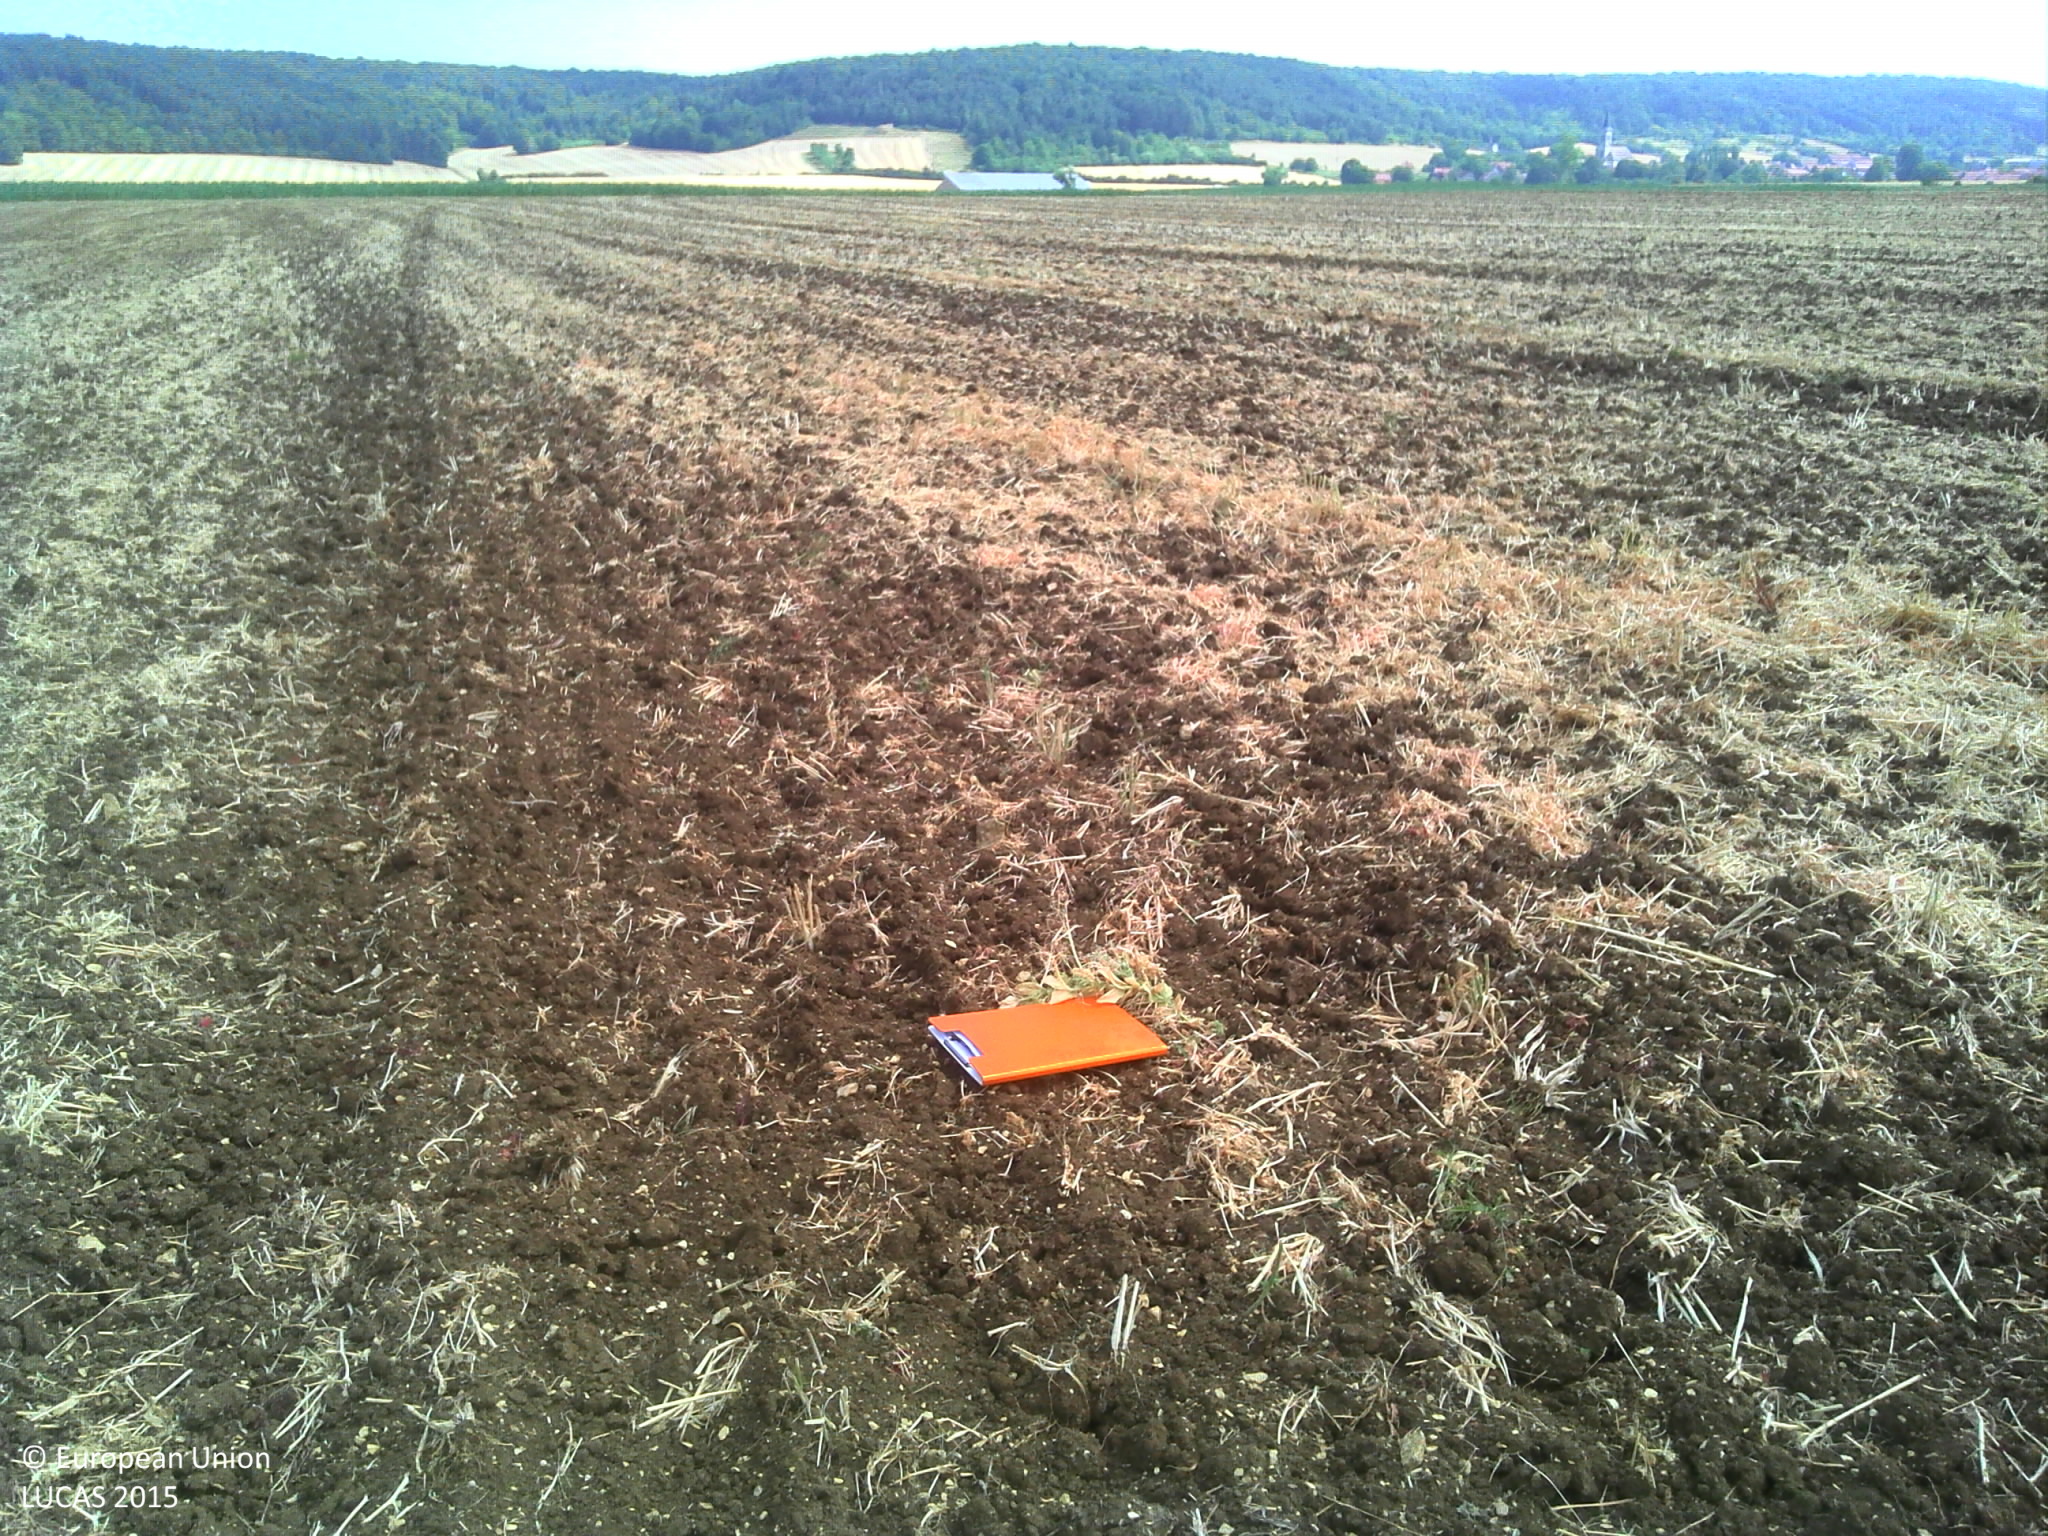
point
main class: Cropland
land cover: Dry pulses
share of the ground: 10 - 25 %
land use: Agriculture (excluding fallow land and kitchen gardens)
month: July
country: FR
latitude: 47.9766
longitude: 4.8412
